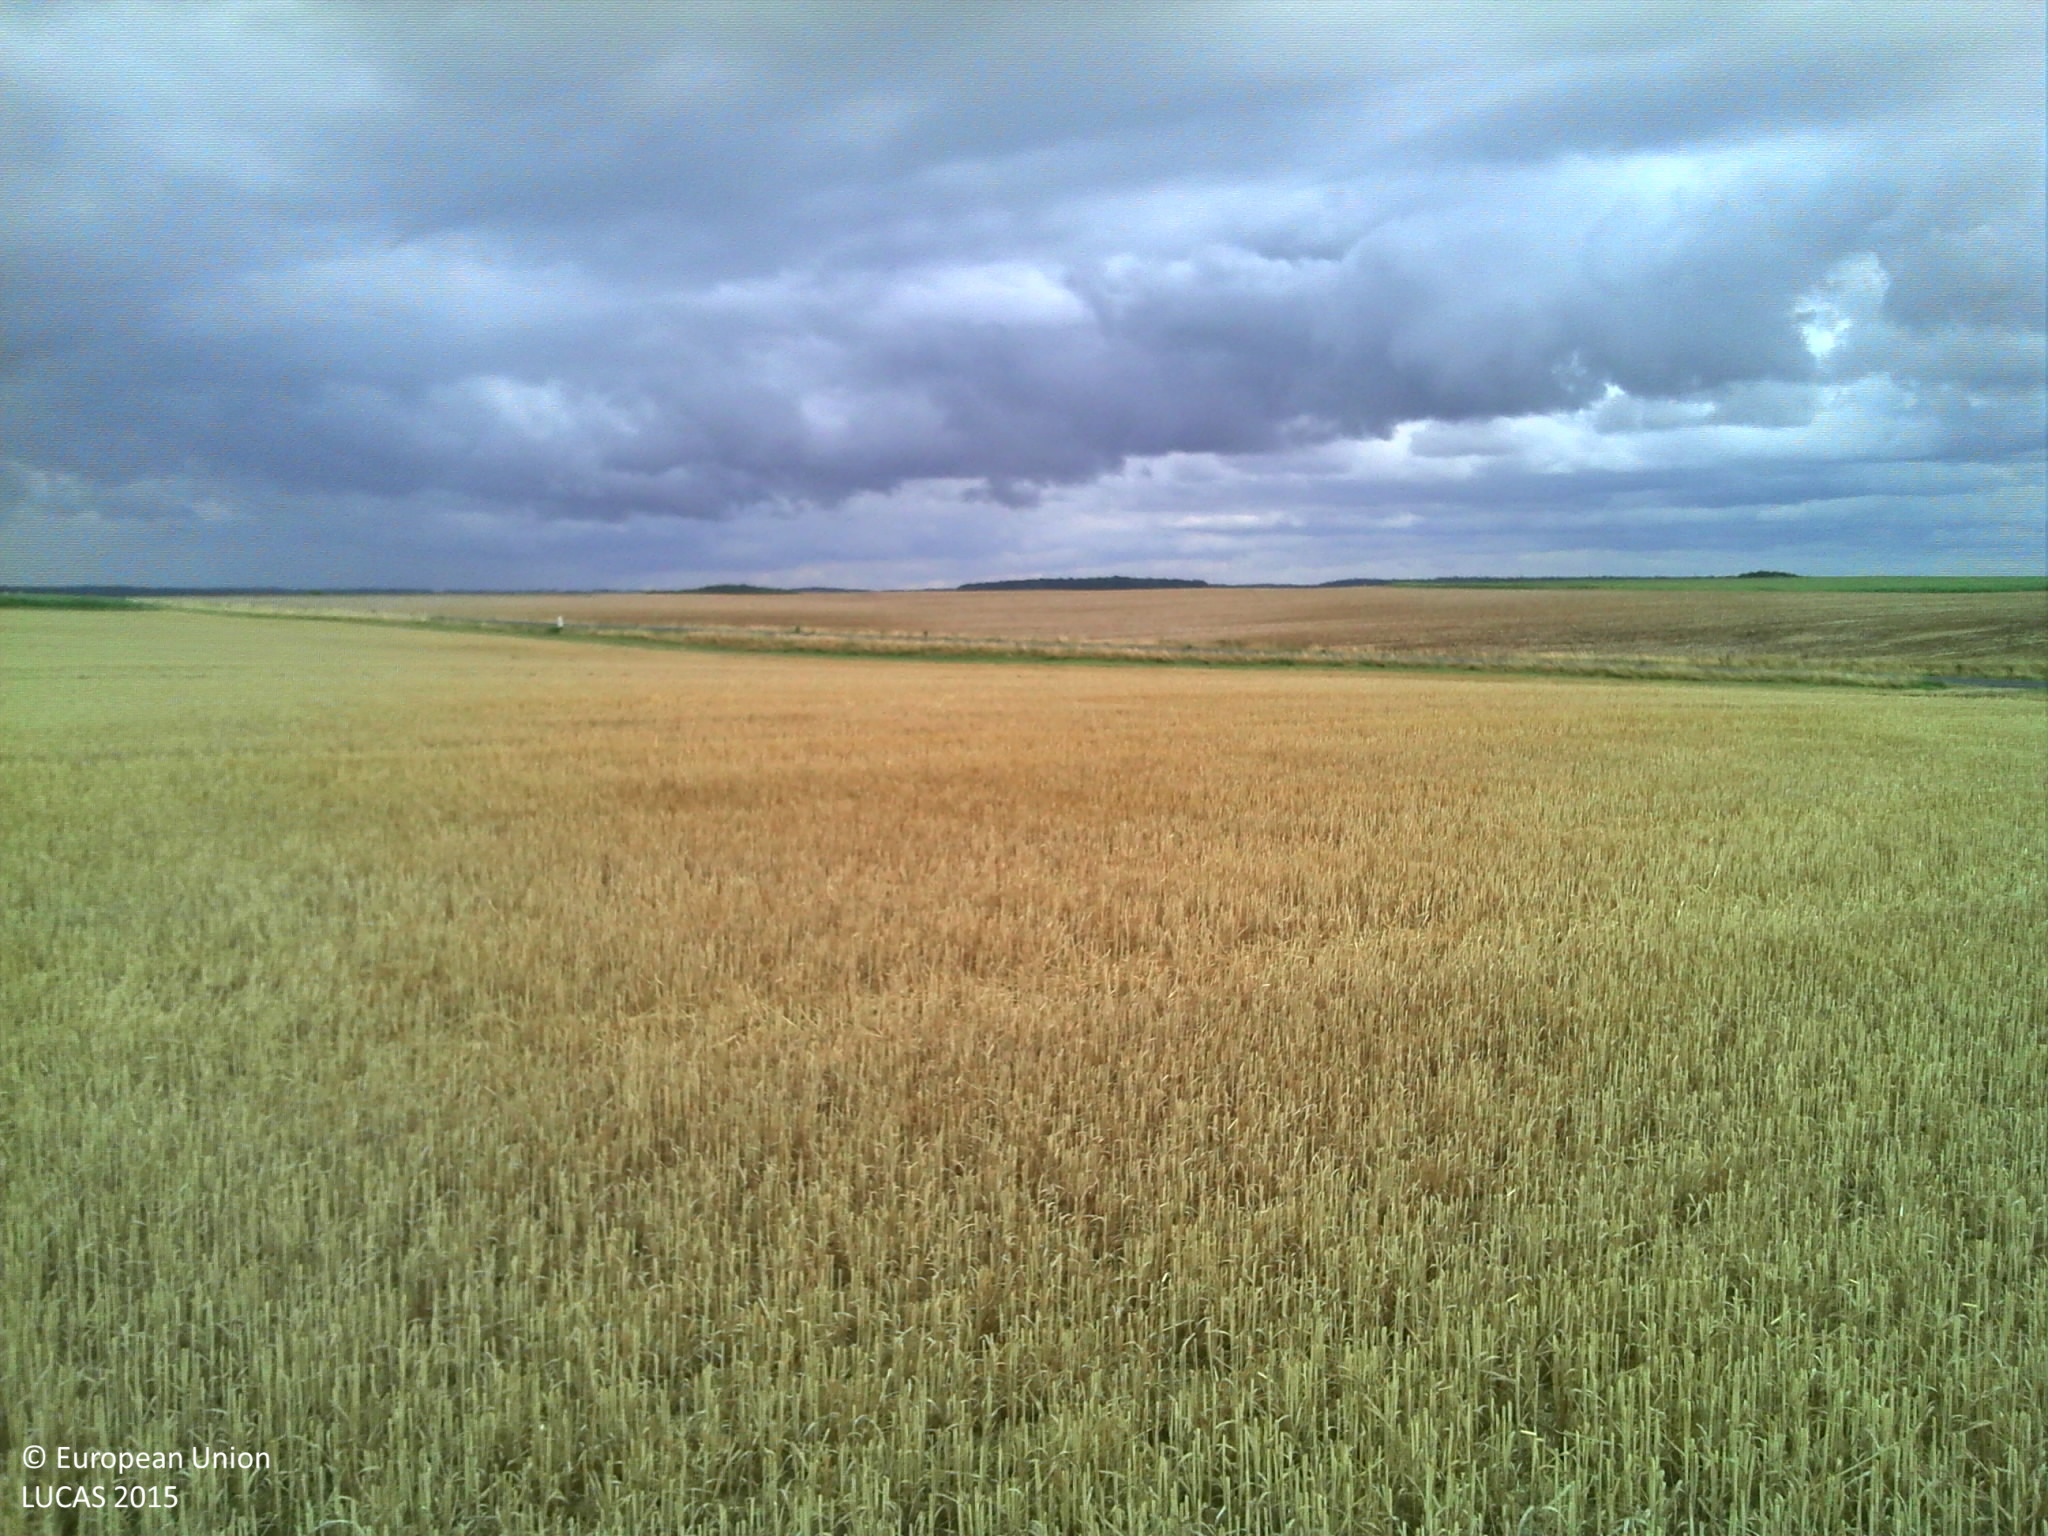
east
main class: Cropland
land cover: Common wheat
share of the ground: > 75 %
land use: Agriculture (excluding fallow land and kitchen gardens)
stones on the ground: < 10 %
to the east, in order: Common wheat; Other bare soil; Grassland without tree/shrub cover; Paved roads, cycling and walking lanes; Grassland without tree/shrub cover; Other bare soil
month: July
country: FR
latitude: 49.1243
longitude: 5.1060
